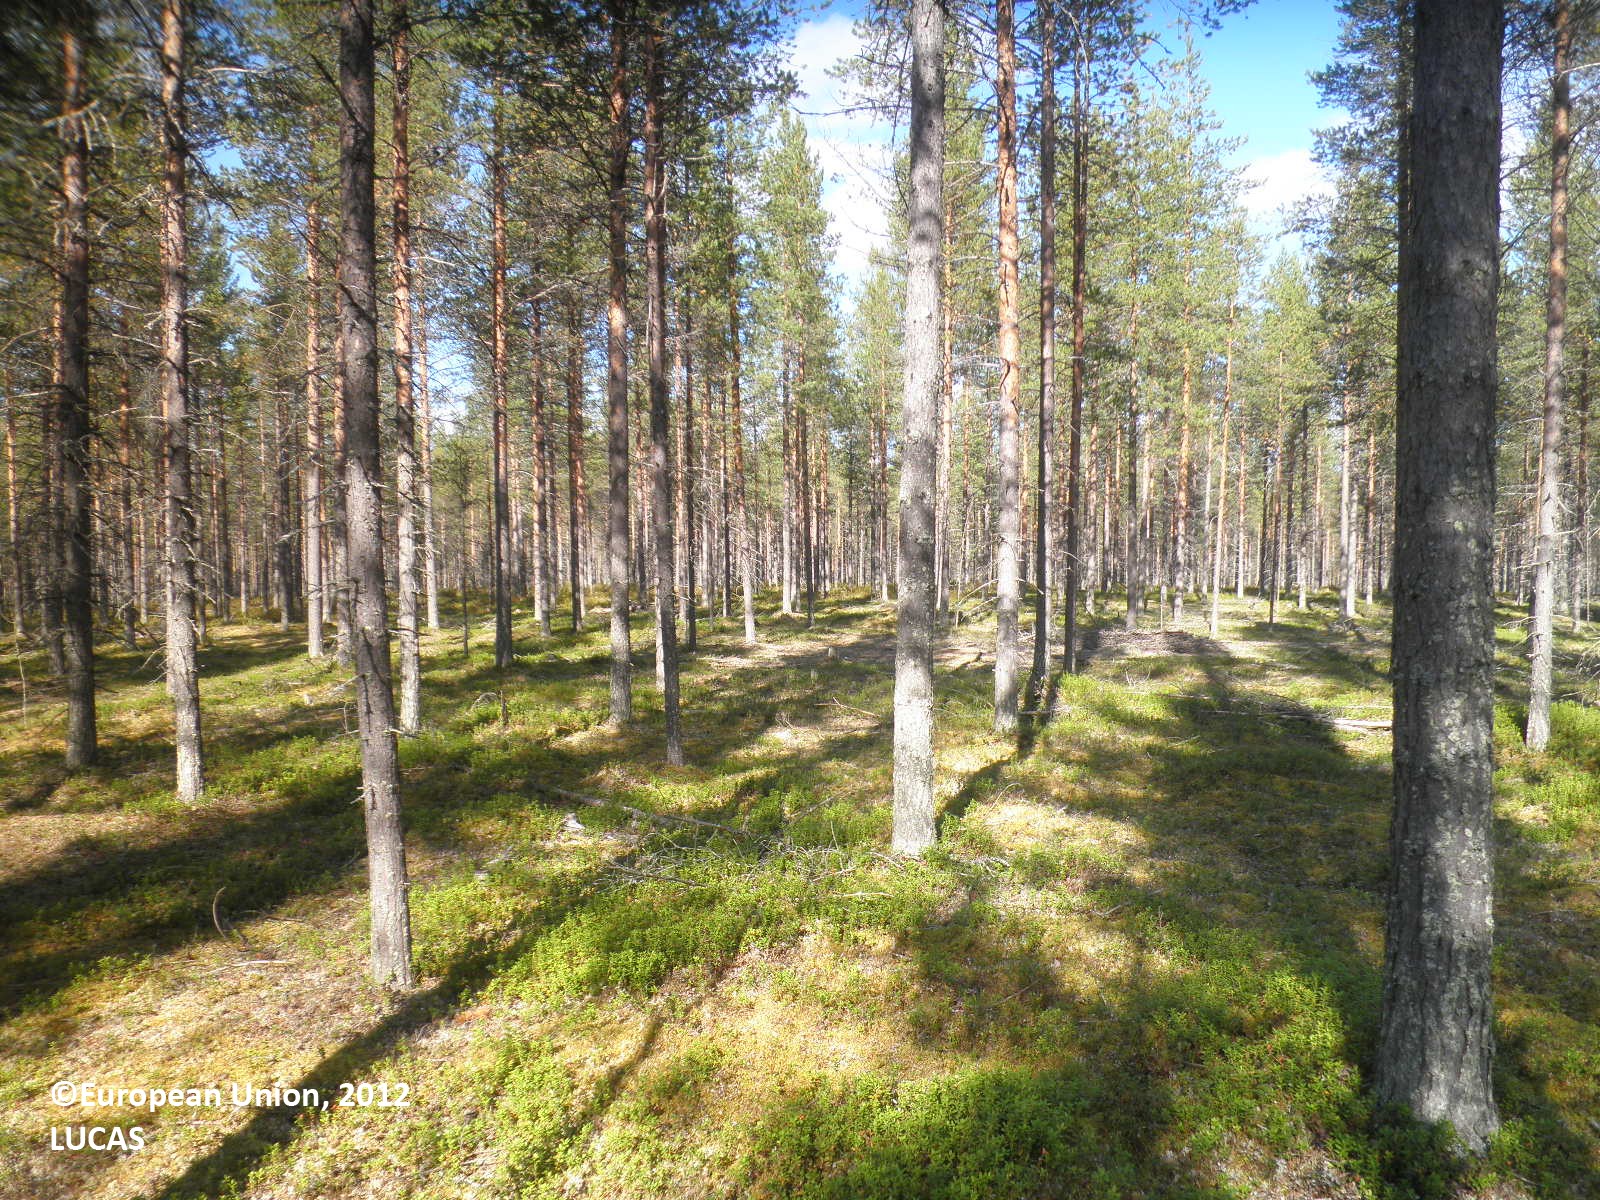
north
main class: Woodland
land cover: Pine dominated coniferous woodland
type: boreal forest
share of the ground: 50 - 75 %
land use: Forestry
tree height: > 5 m
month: August
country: FI
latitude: 67.6212
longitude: 28.6547
